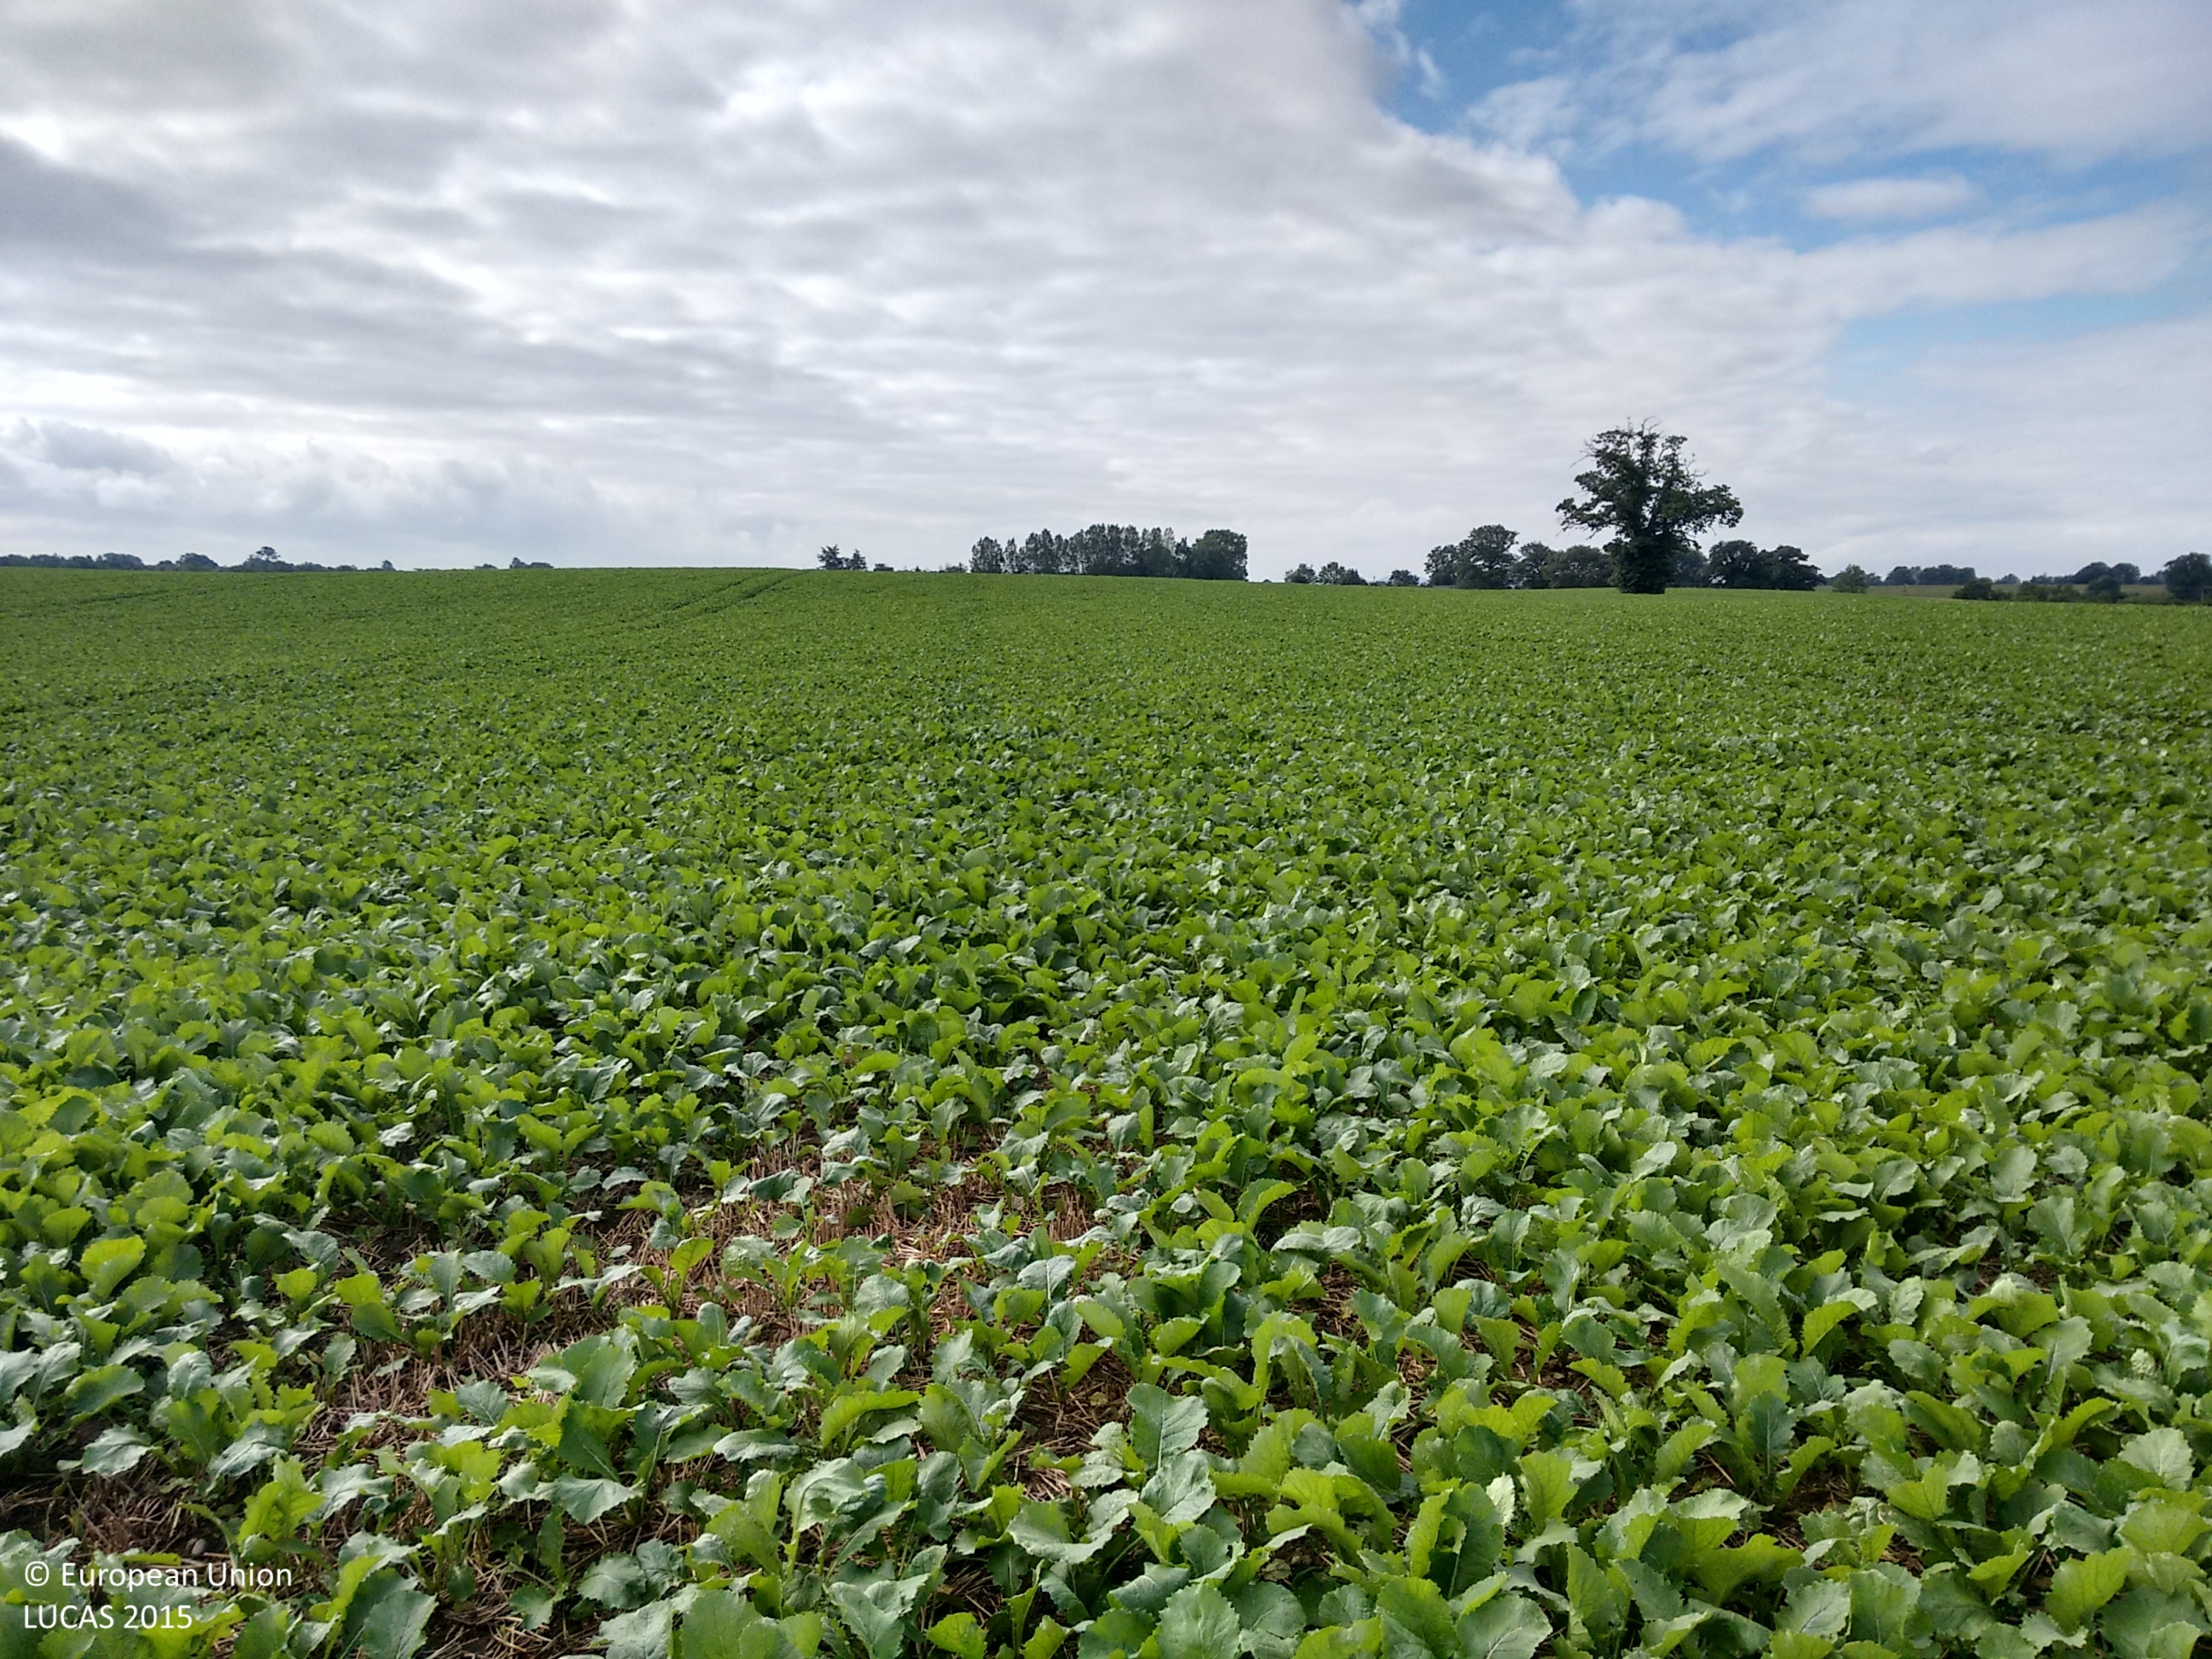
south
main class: Cropland
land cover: Sugar beet
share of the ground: > 75 %
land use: Agriculture (excluding fallow land and kitchen gardens)
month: September
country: GB
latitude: 52.8456
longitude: -2.9769
